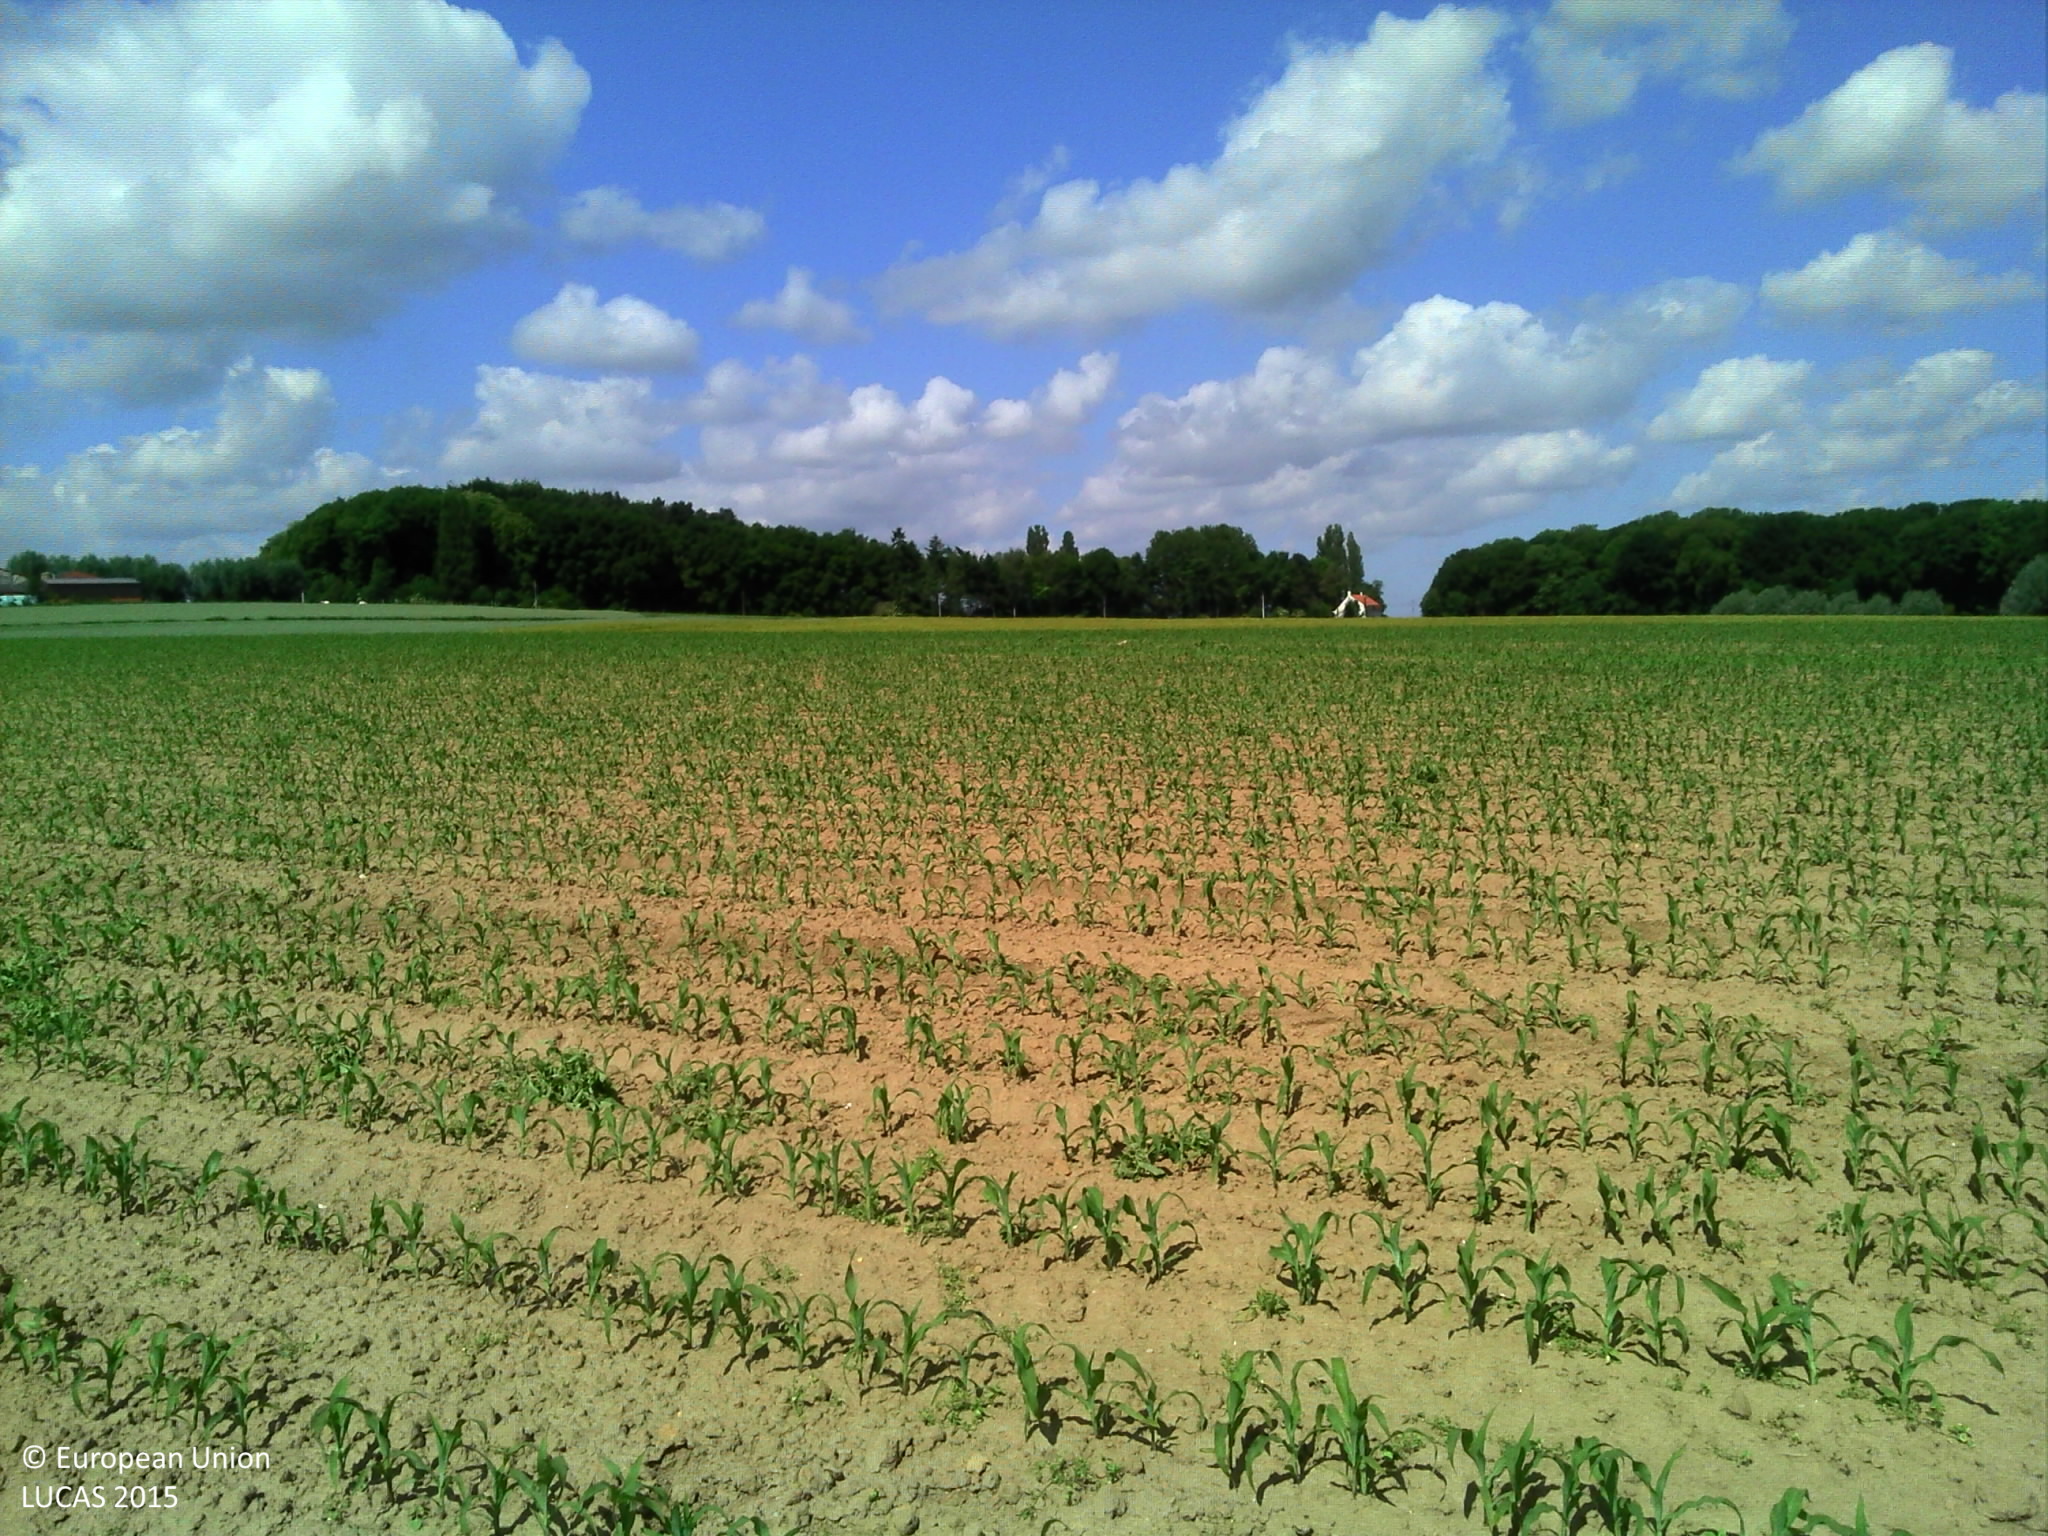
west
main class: Cropland
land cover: Maize
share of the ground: < 10 %
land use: Agriculture (excluding fallow land and kitchen gardens)
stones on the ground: < 10 %
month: June
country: BE
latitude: 50.7921
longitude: 2.8820
